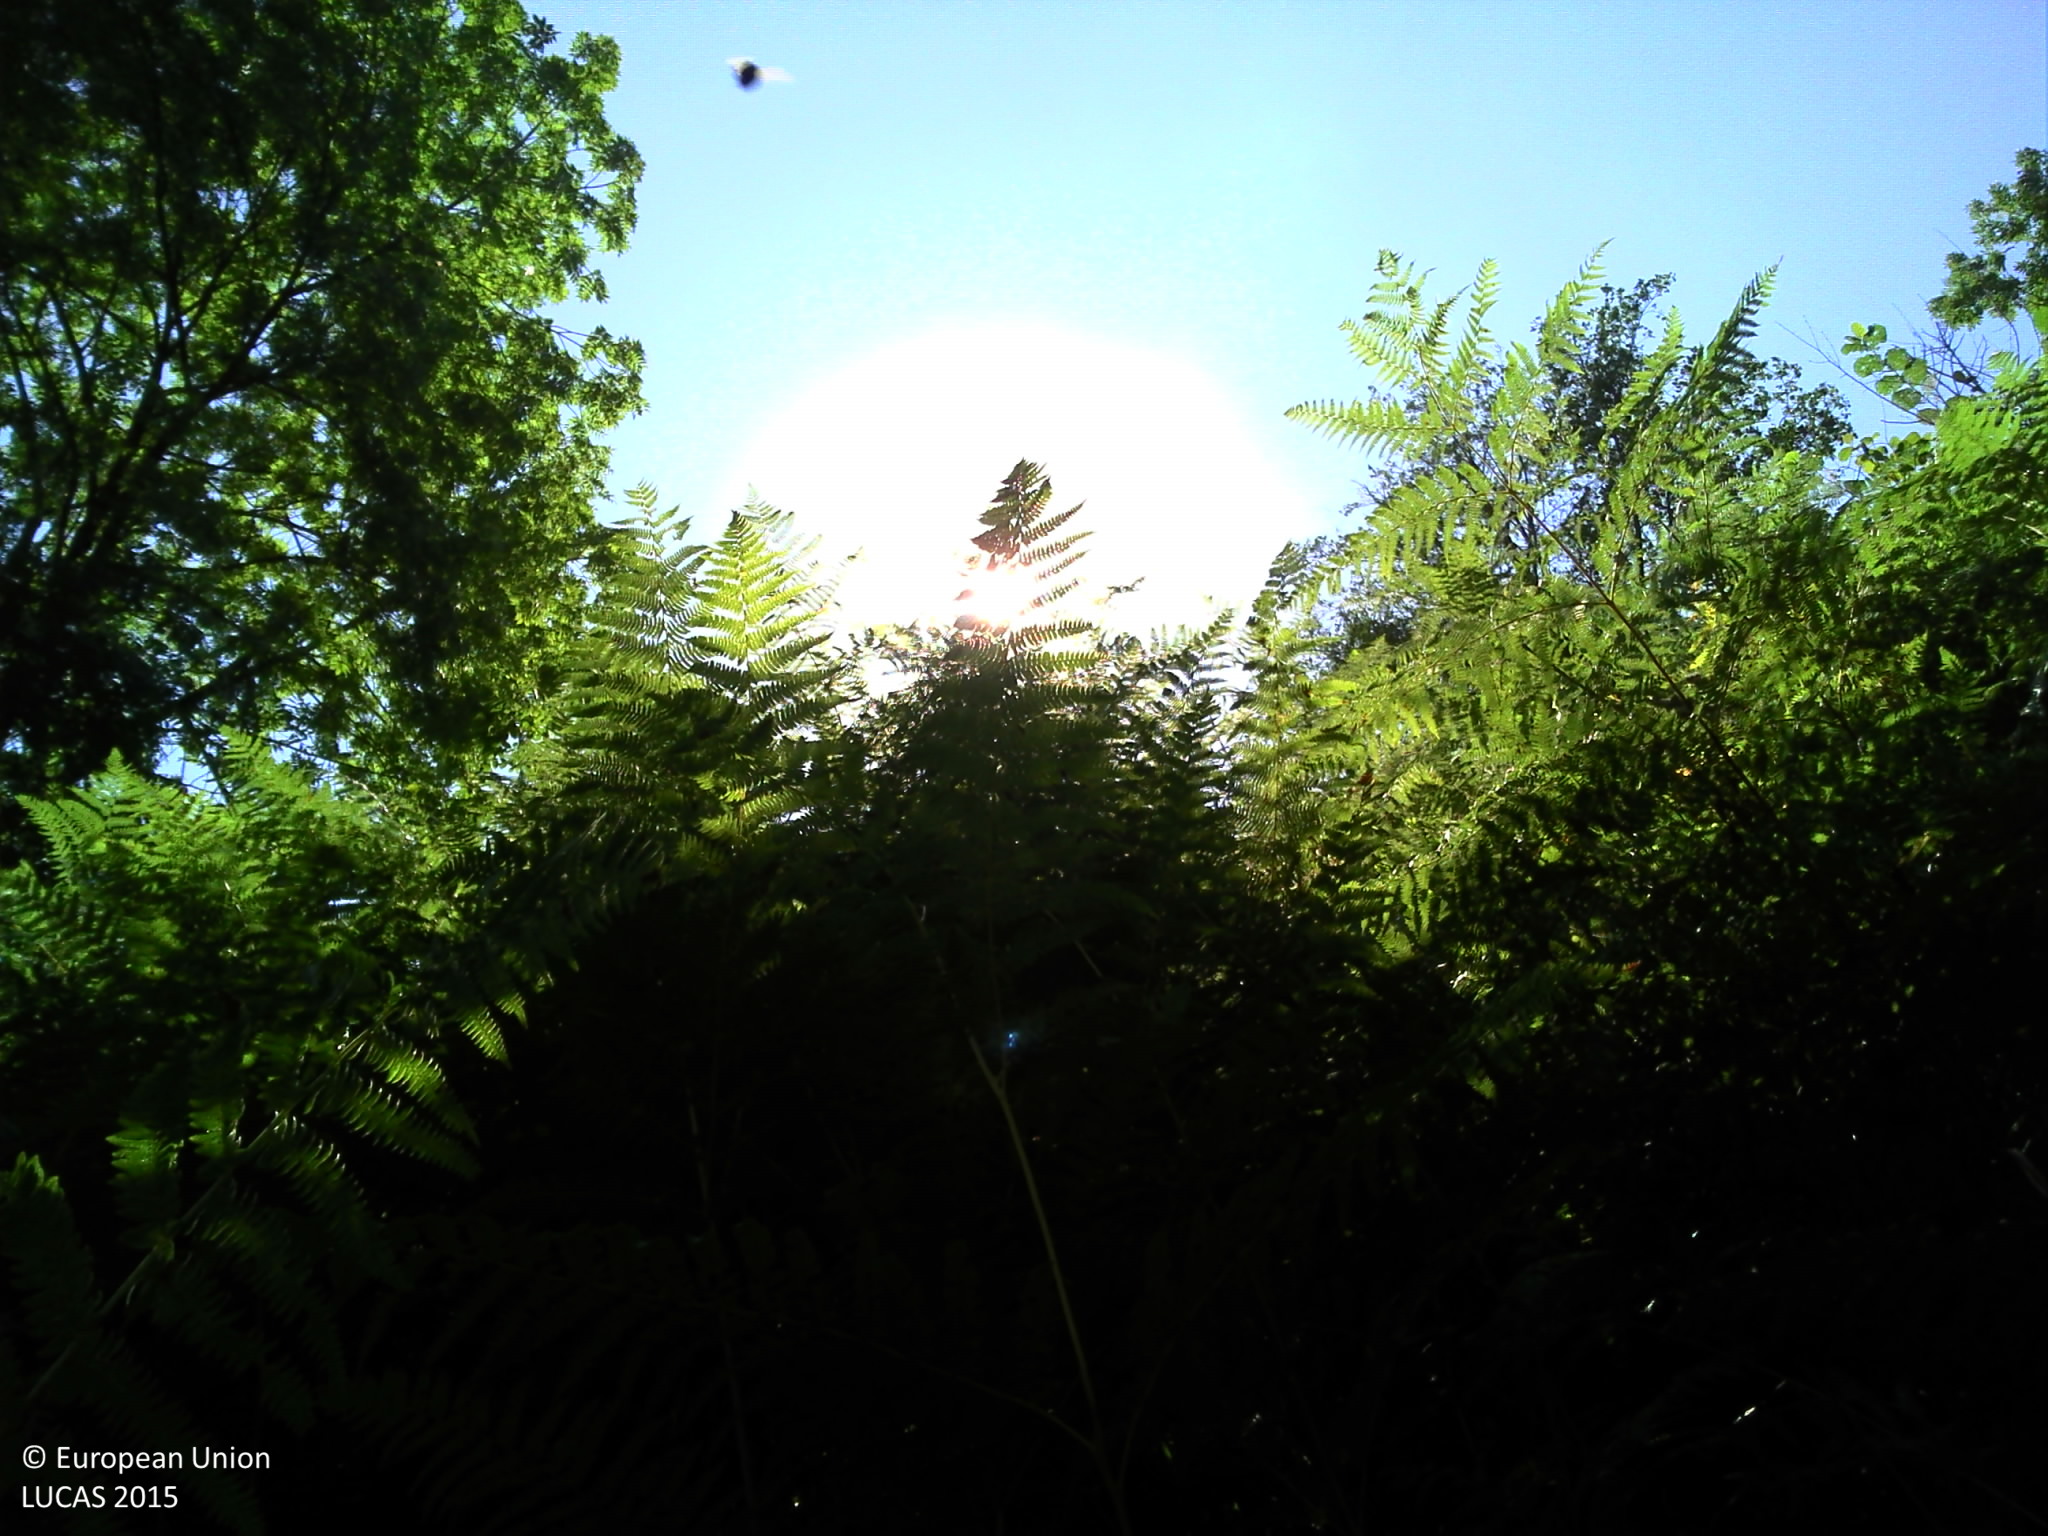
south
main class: Woodland
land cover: Broadleaved woodland
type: acidophilous oak and oak-birch forest
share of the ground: 50 - 75 %
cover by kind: broadleaved forest trees 60 %, herbaceous plants 30 %, shrubs 5 %, consolidated bare surface 5 %
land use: Forestry
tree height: > 5 m
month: September
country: FR
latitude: 43.0141
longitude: -0.8673
